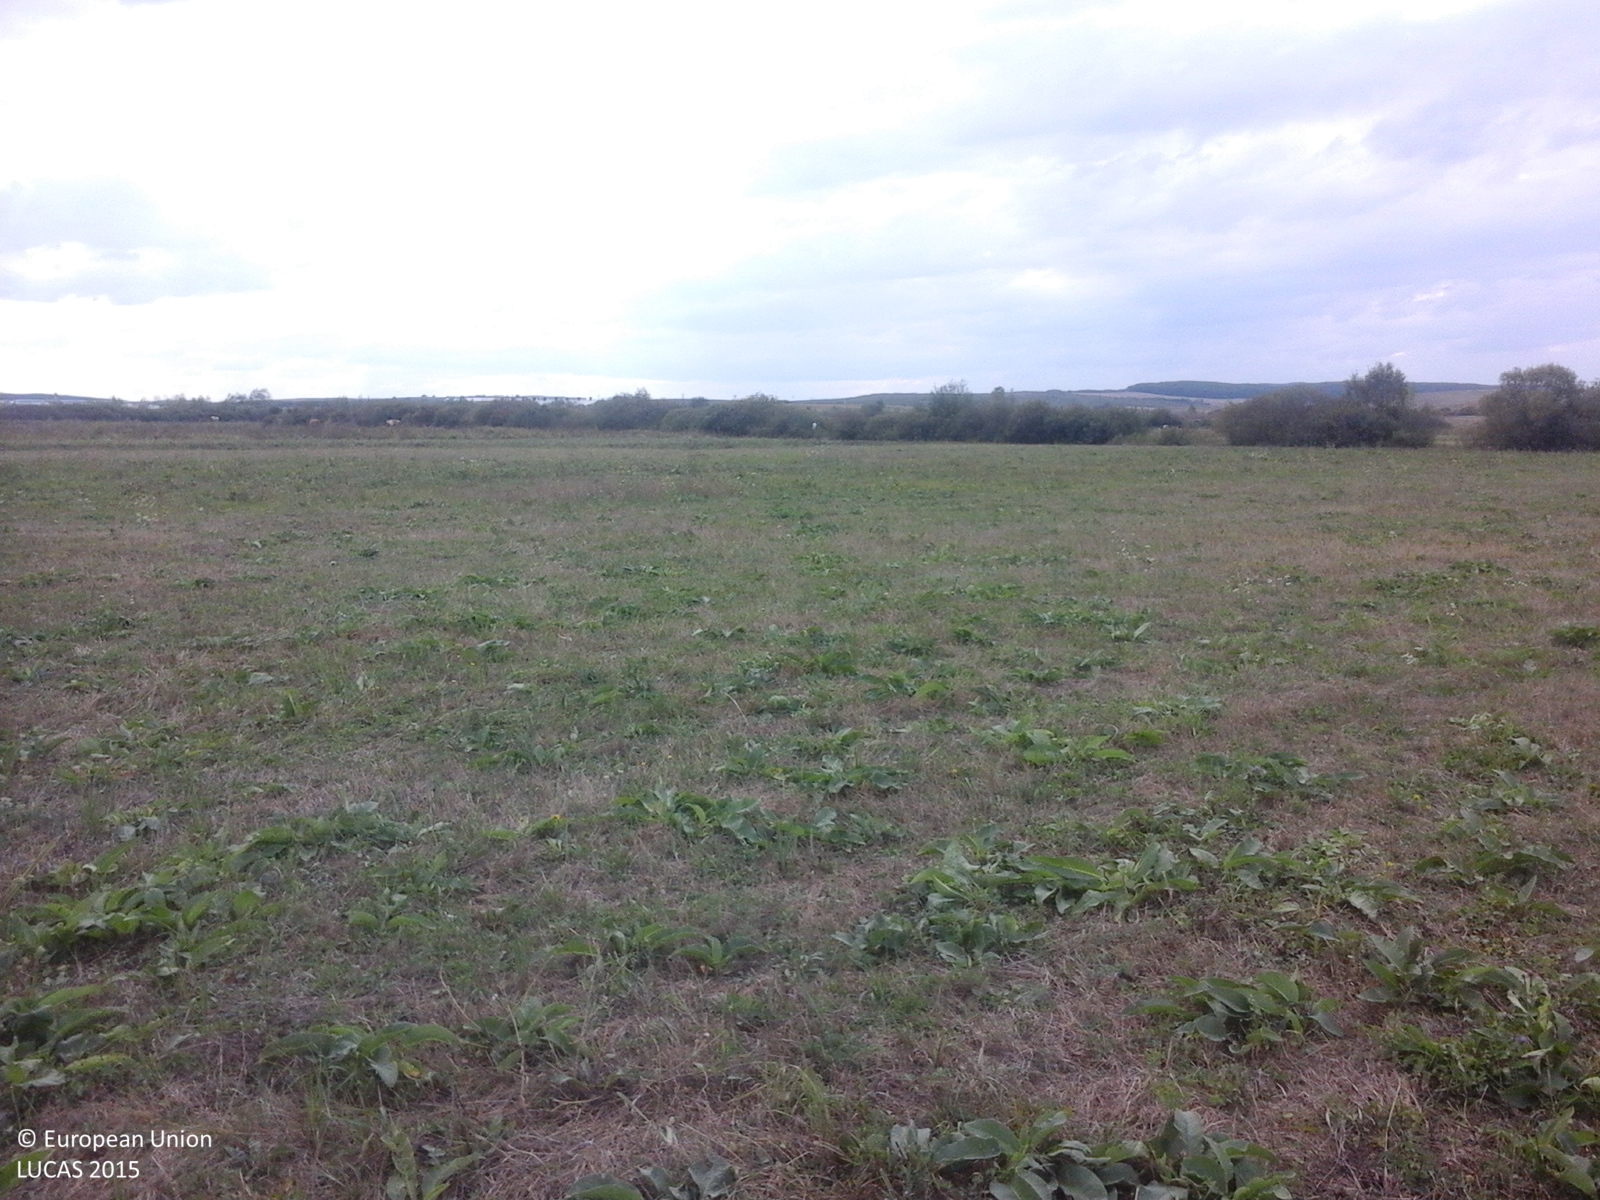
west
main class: Grassland
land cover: Grassland without tree/shrub cover
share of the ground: > 75 %
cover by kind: herbaceous plants 100 %
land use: Agriculture (excluding fallow land and kitchen gardens)
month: September
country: RO
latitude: 47.4635
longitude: 23.1882
